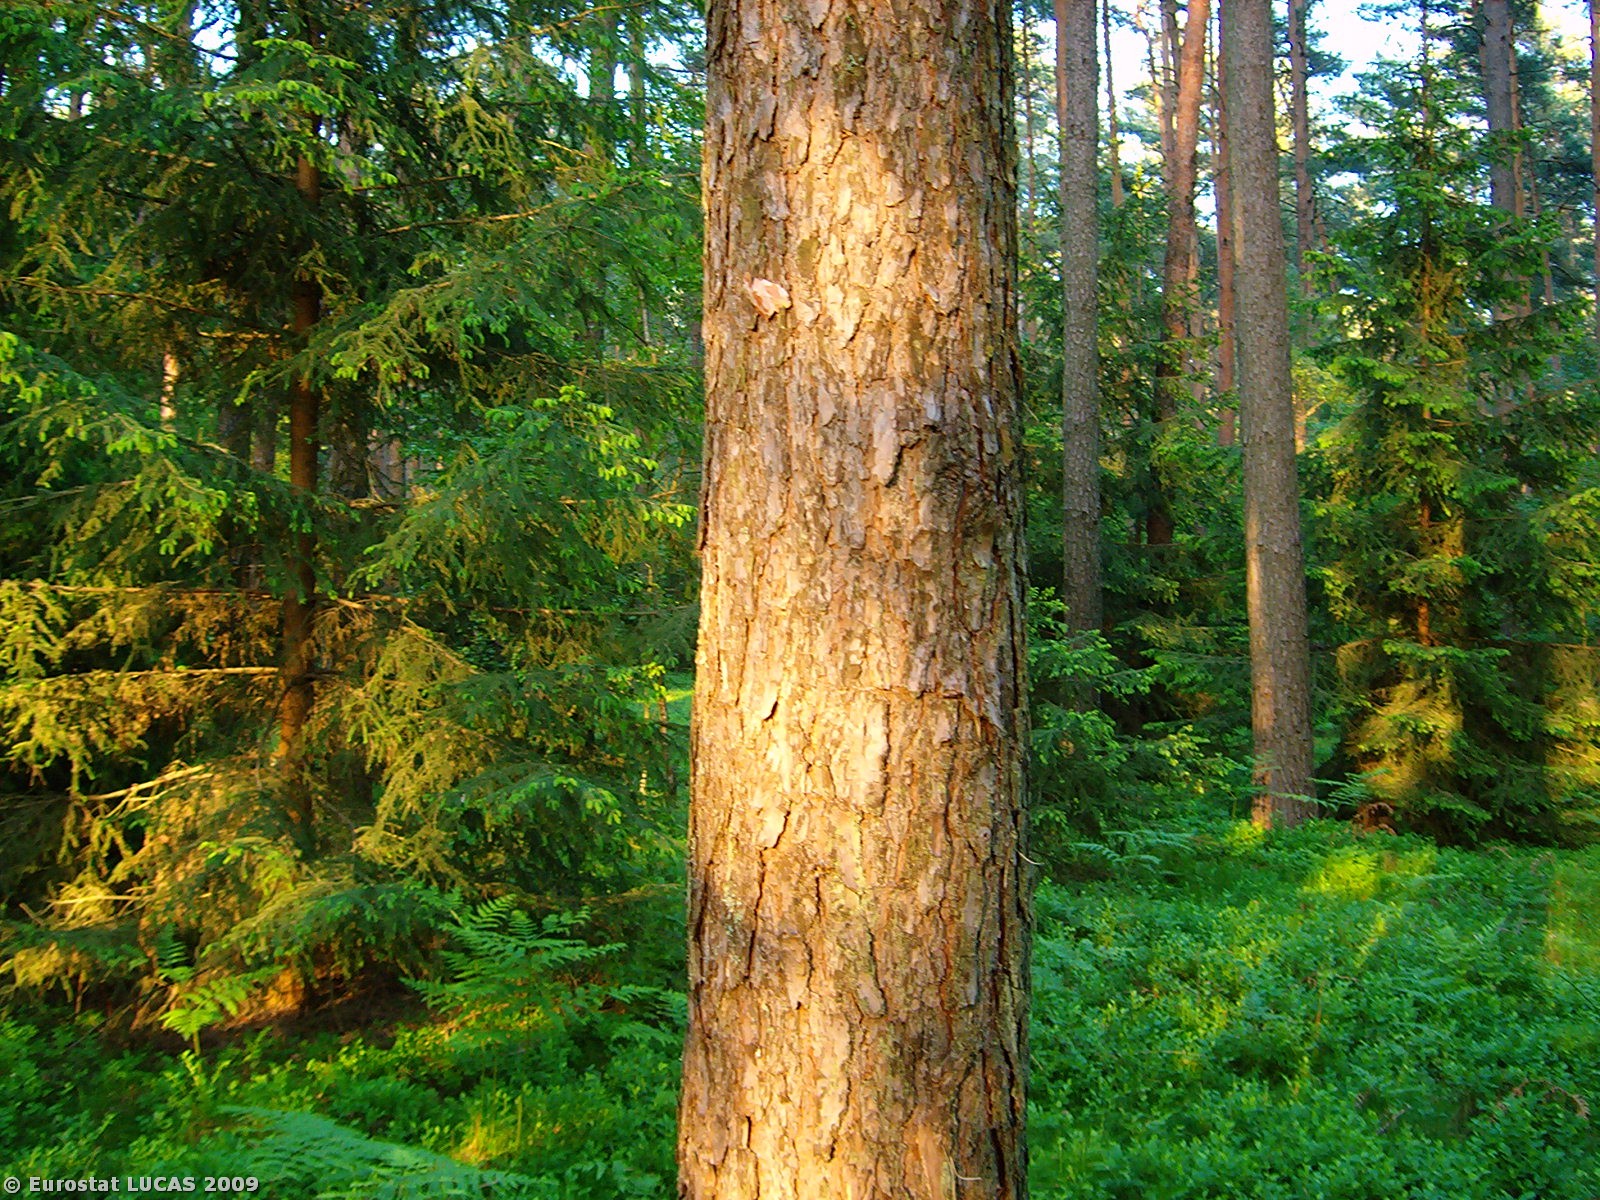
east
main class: Woodland
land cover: Coniferous woodland
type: hemiboreal forest and nemoral coniferous forest and mixed broadleaved-coniferous forest
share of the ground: 50 - 75 %
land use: Forestry
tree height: > 5 m
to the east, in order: Coniferous woodland; Paved roads, cycling and walking lanes; Coniferous woodland
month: May
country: PL
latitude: 52.7315
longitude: 16.3300
